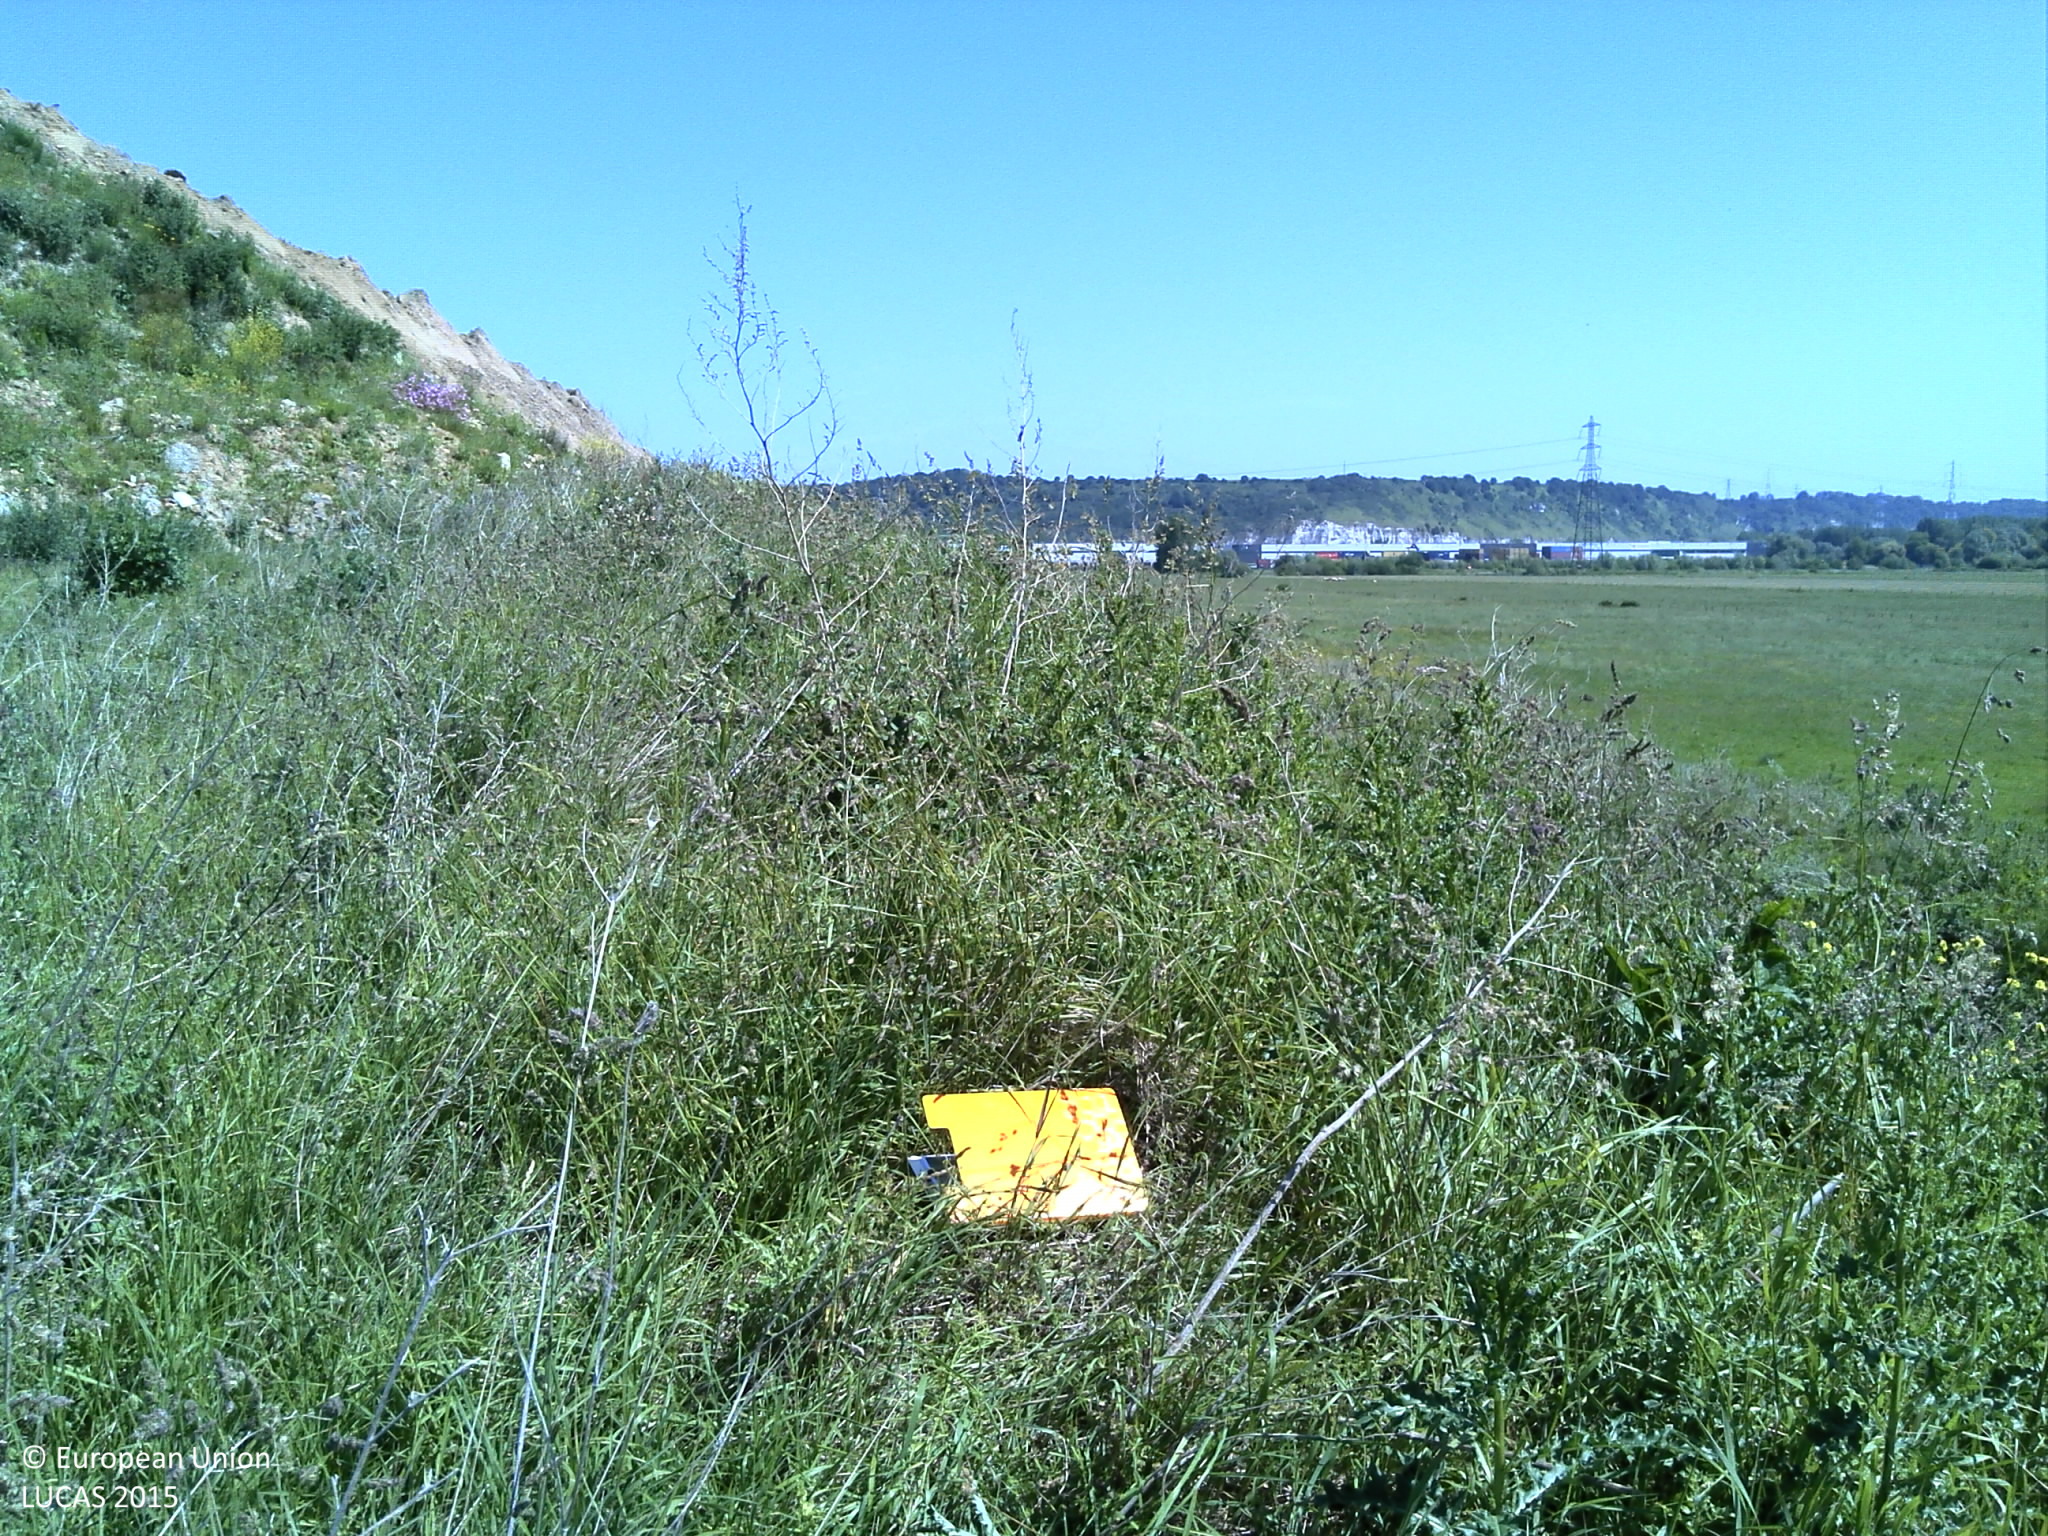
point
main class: Grassland
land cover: Spontaneously vegetated surfaces
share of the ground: > 75 %
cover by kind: herbaceous plants 100 %
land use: Semi-natural and natural areas not in use
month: June
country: FR
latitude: 49.4641
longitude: 0.3270
